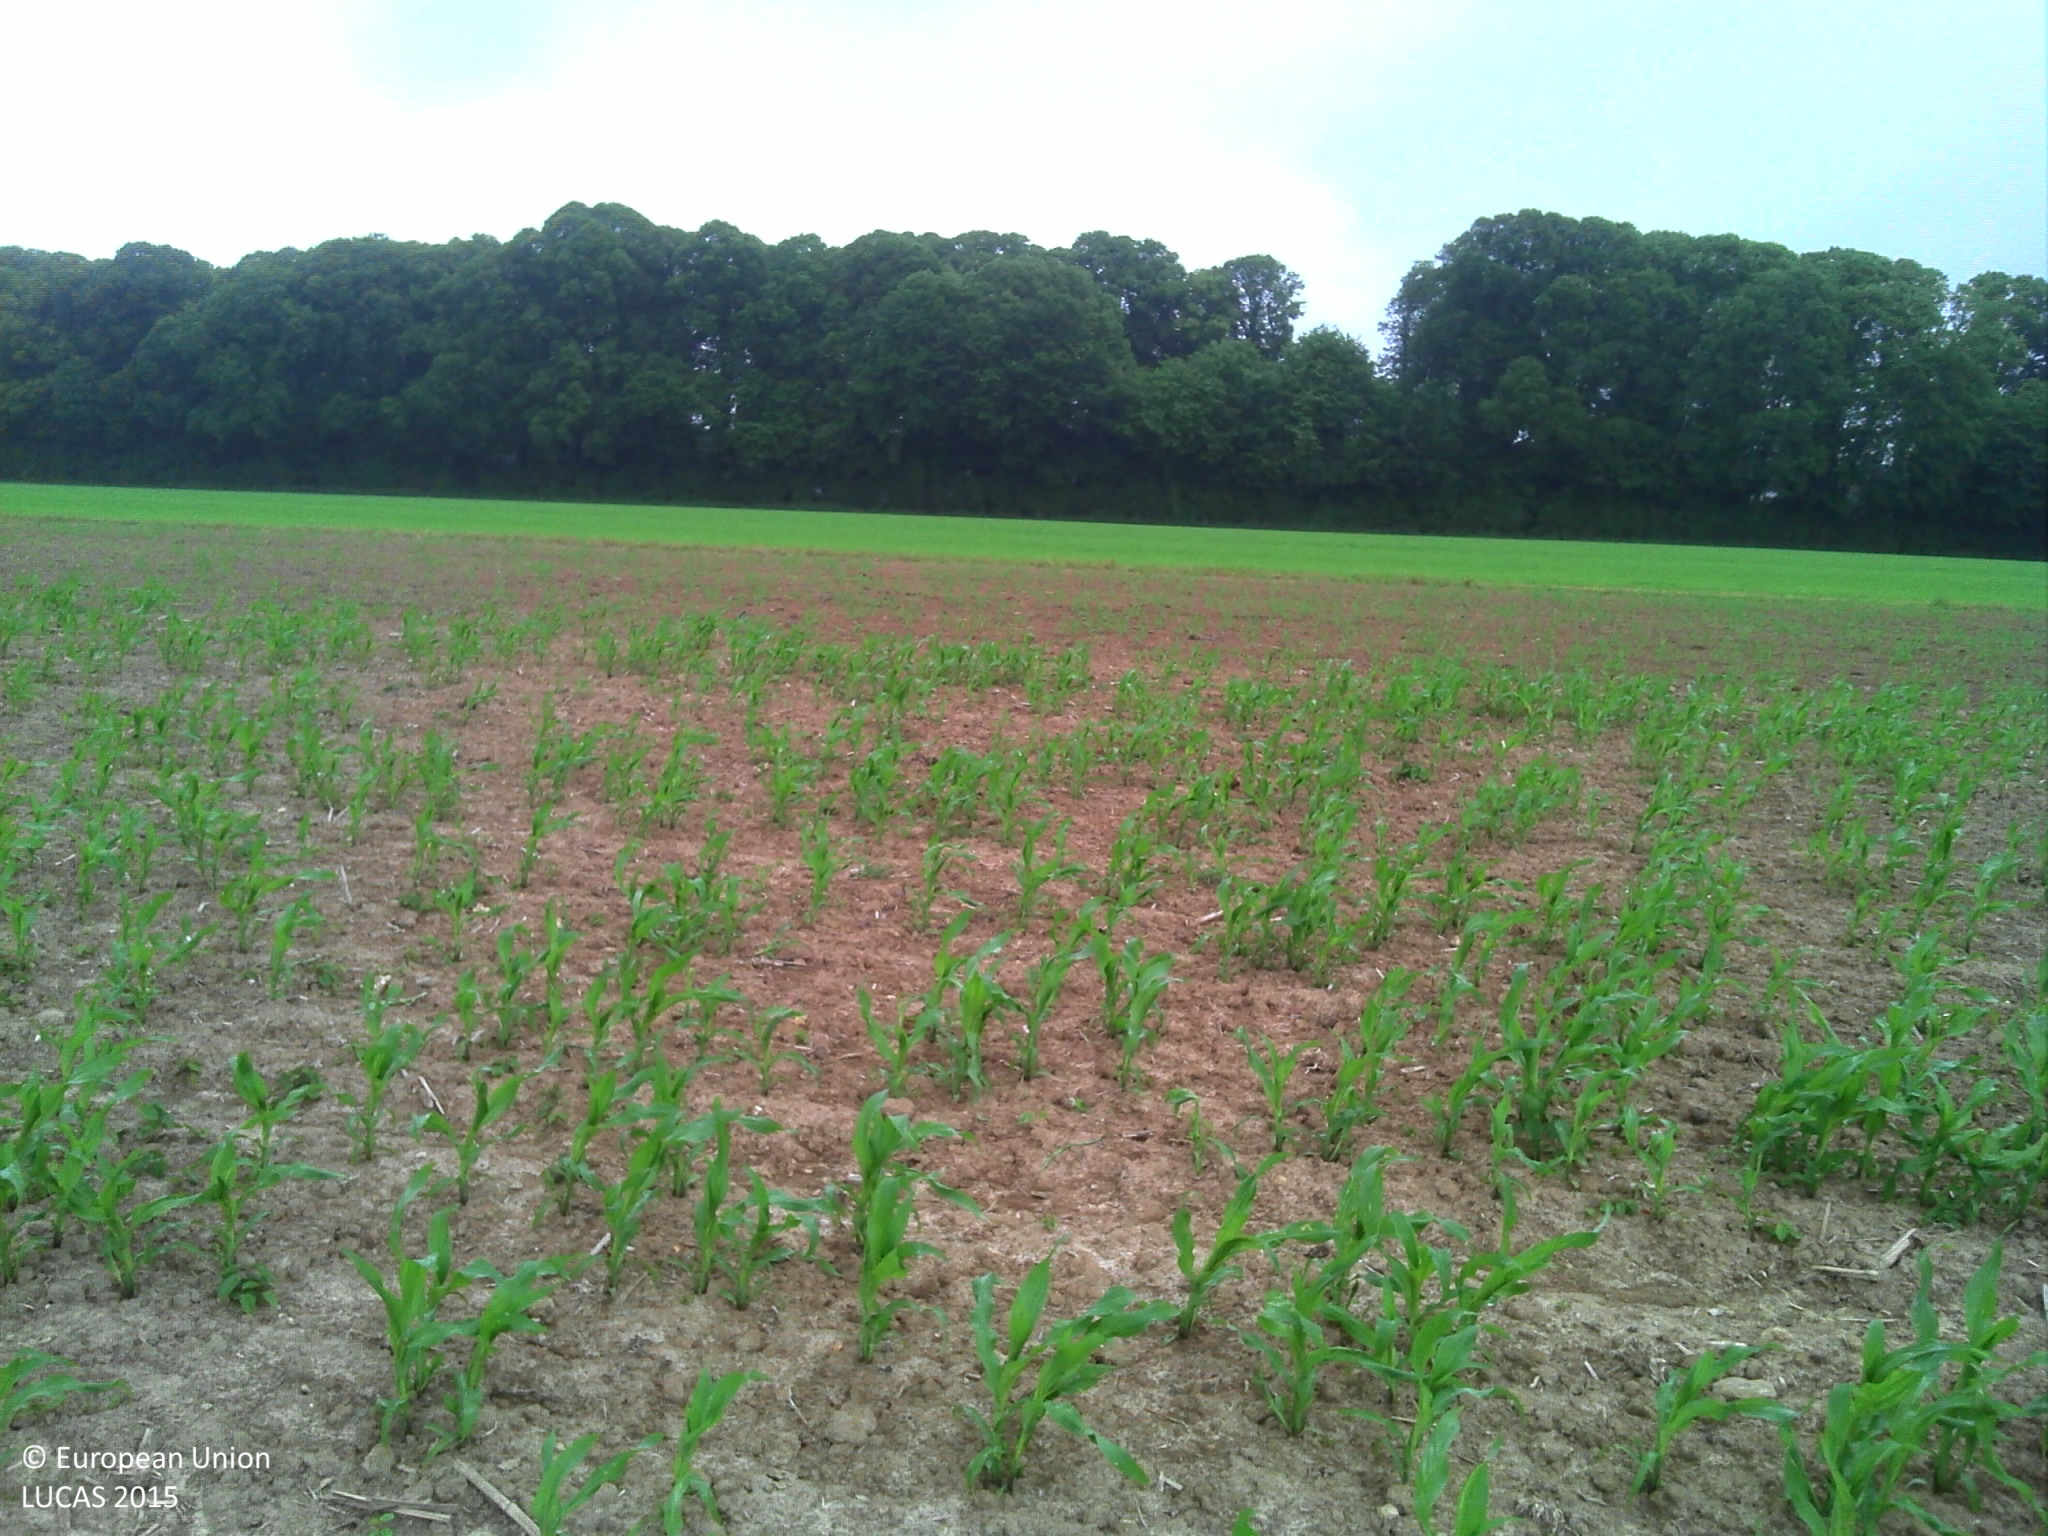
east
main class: Cropland
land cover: Maize
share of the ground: 10 - 25 %
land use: Agriculture (excluding fallow land and kitchen gardens)
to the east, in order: Maize; Temporary grasslands; Broadleaved woodland; Grass margins; Tracks; Grass margins; Broadleaved woodland; Maize
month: June
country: FR
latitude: 49.2702
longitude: -0.0230
